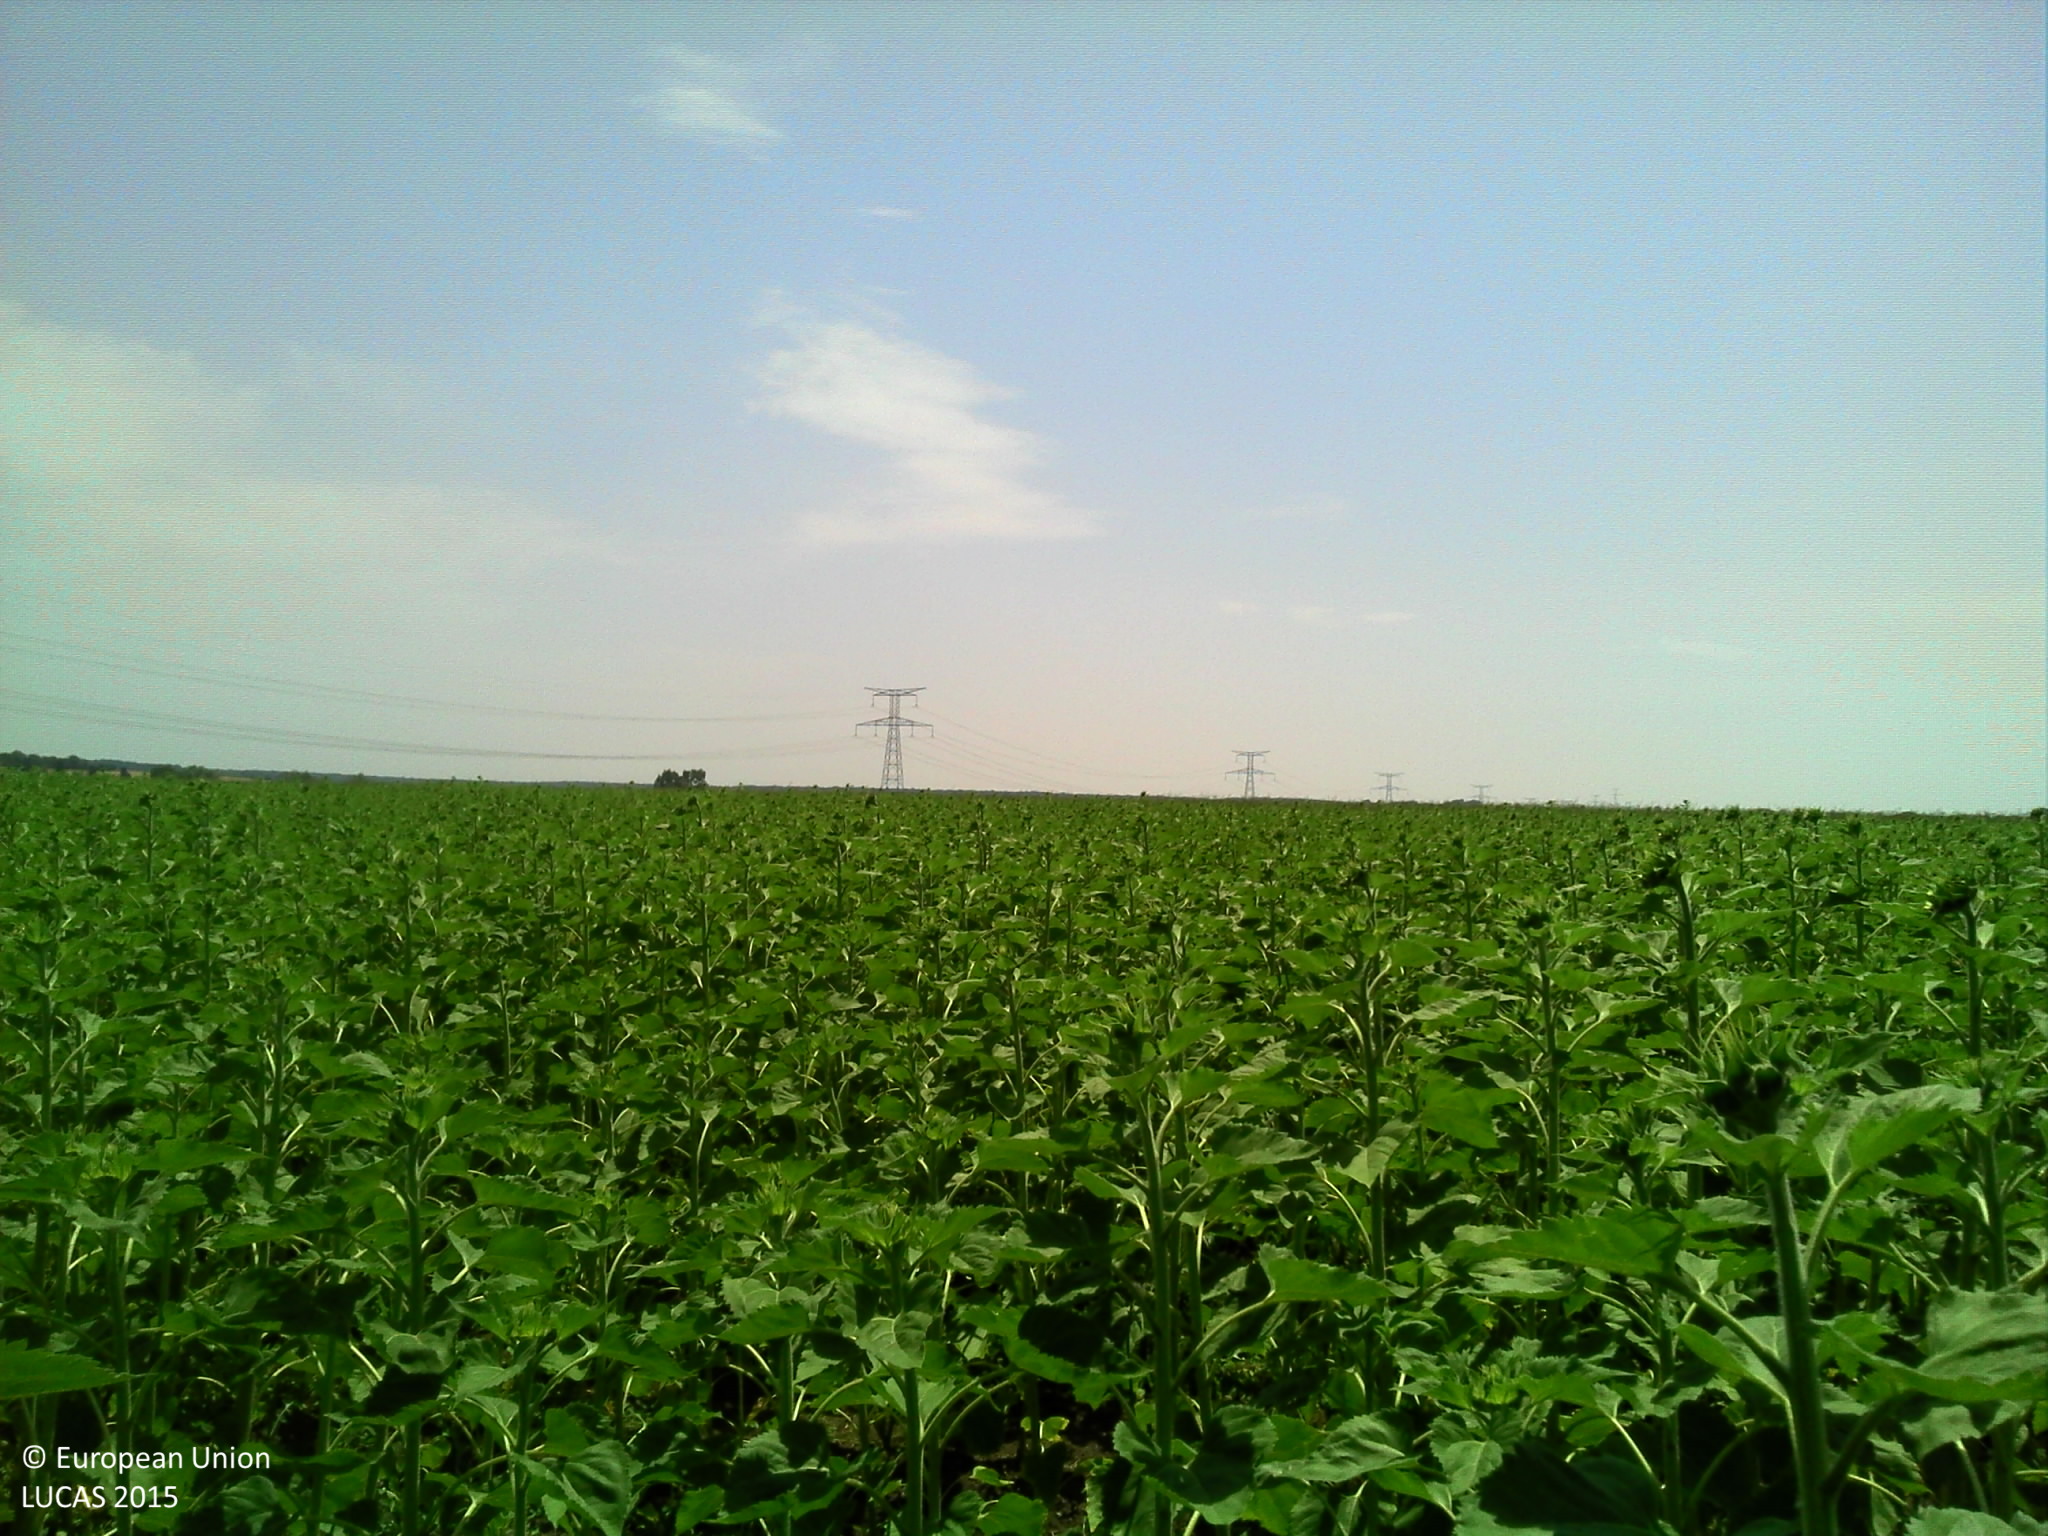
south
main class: Cropland
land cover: Sunflower
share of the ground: > 75 %
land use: Agriculture (excluding fallow land and kitchen gardens)
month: July
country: FR
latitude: 46.1040
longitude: 3.2852
